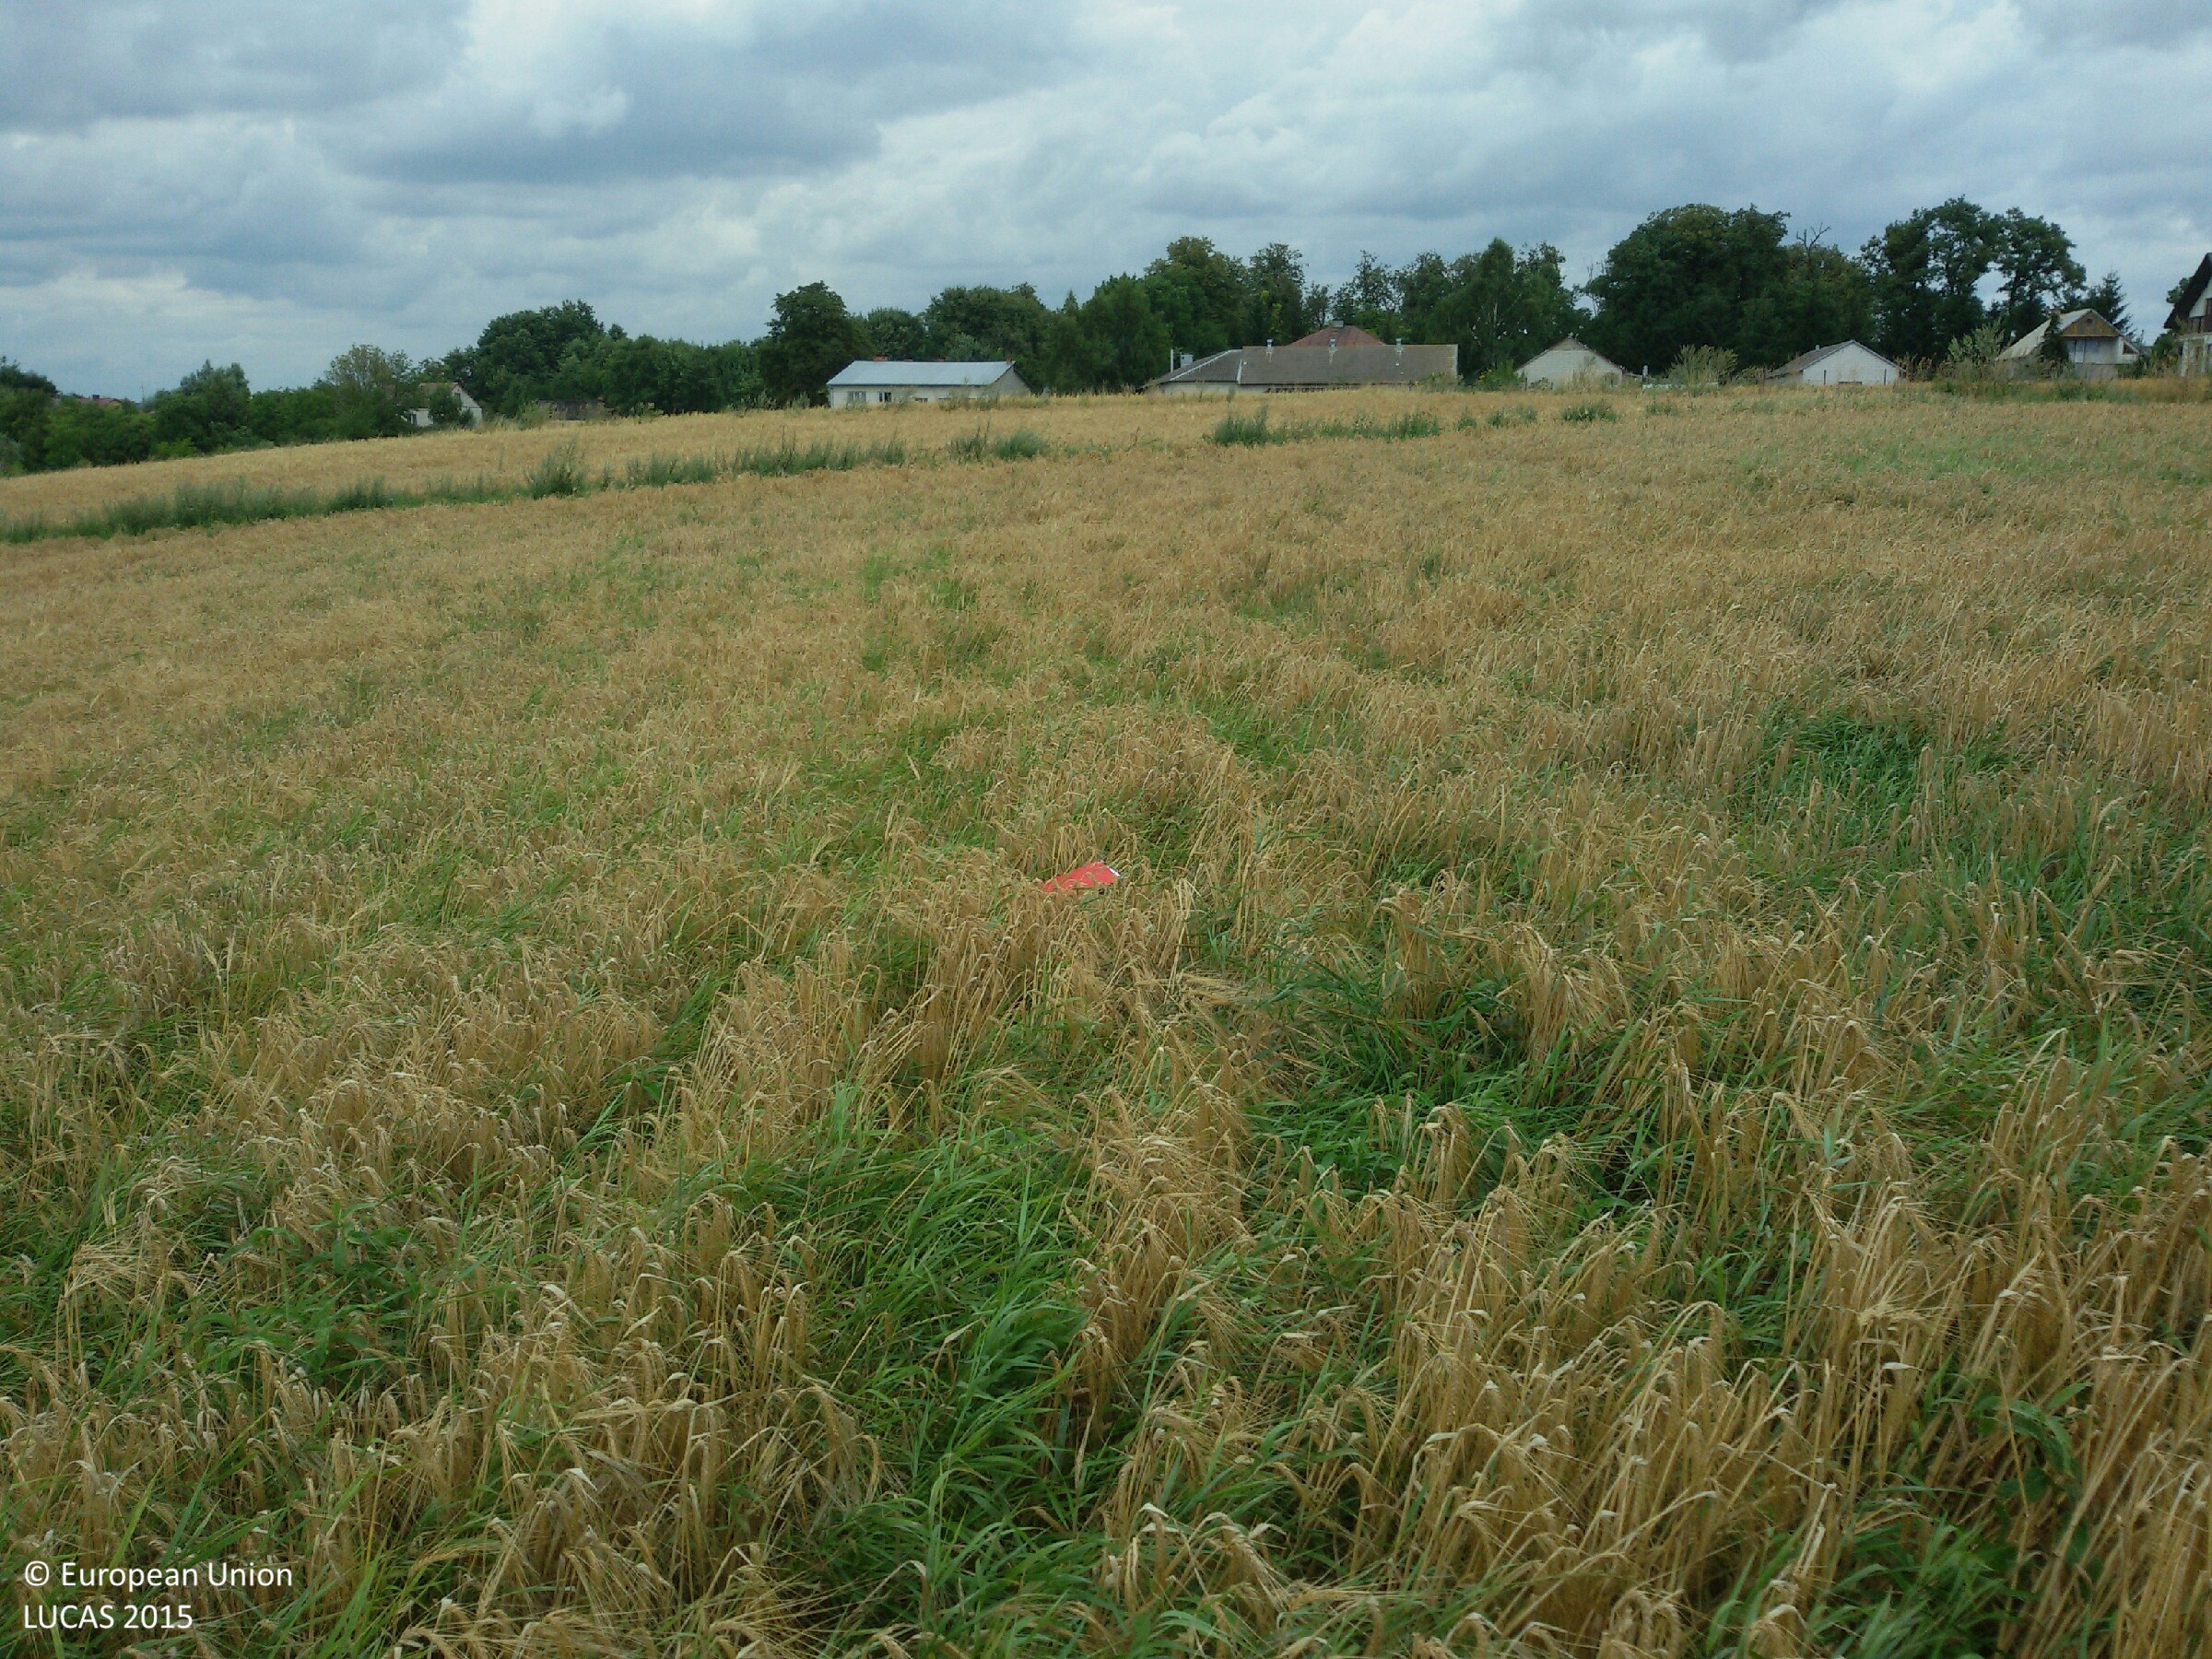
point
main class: Cropland
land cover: Barley
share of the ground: > 75 %
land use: Agriculture (excluding fallow land and kitchen gardens)
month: July
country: PL
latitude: 50.7011
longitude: 21.3905
